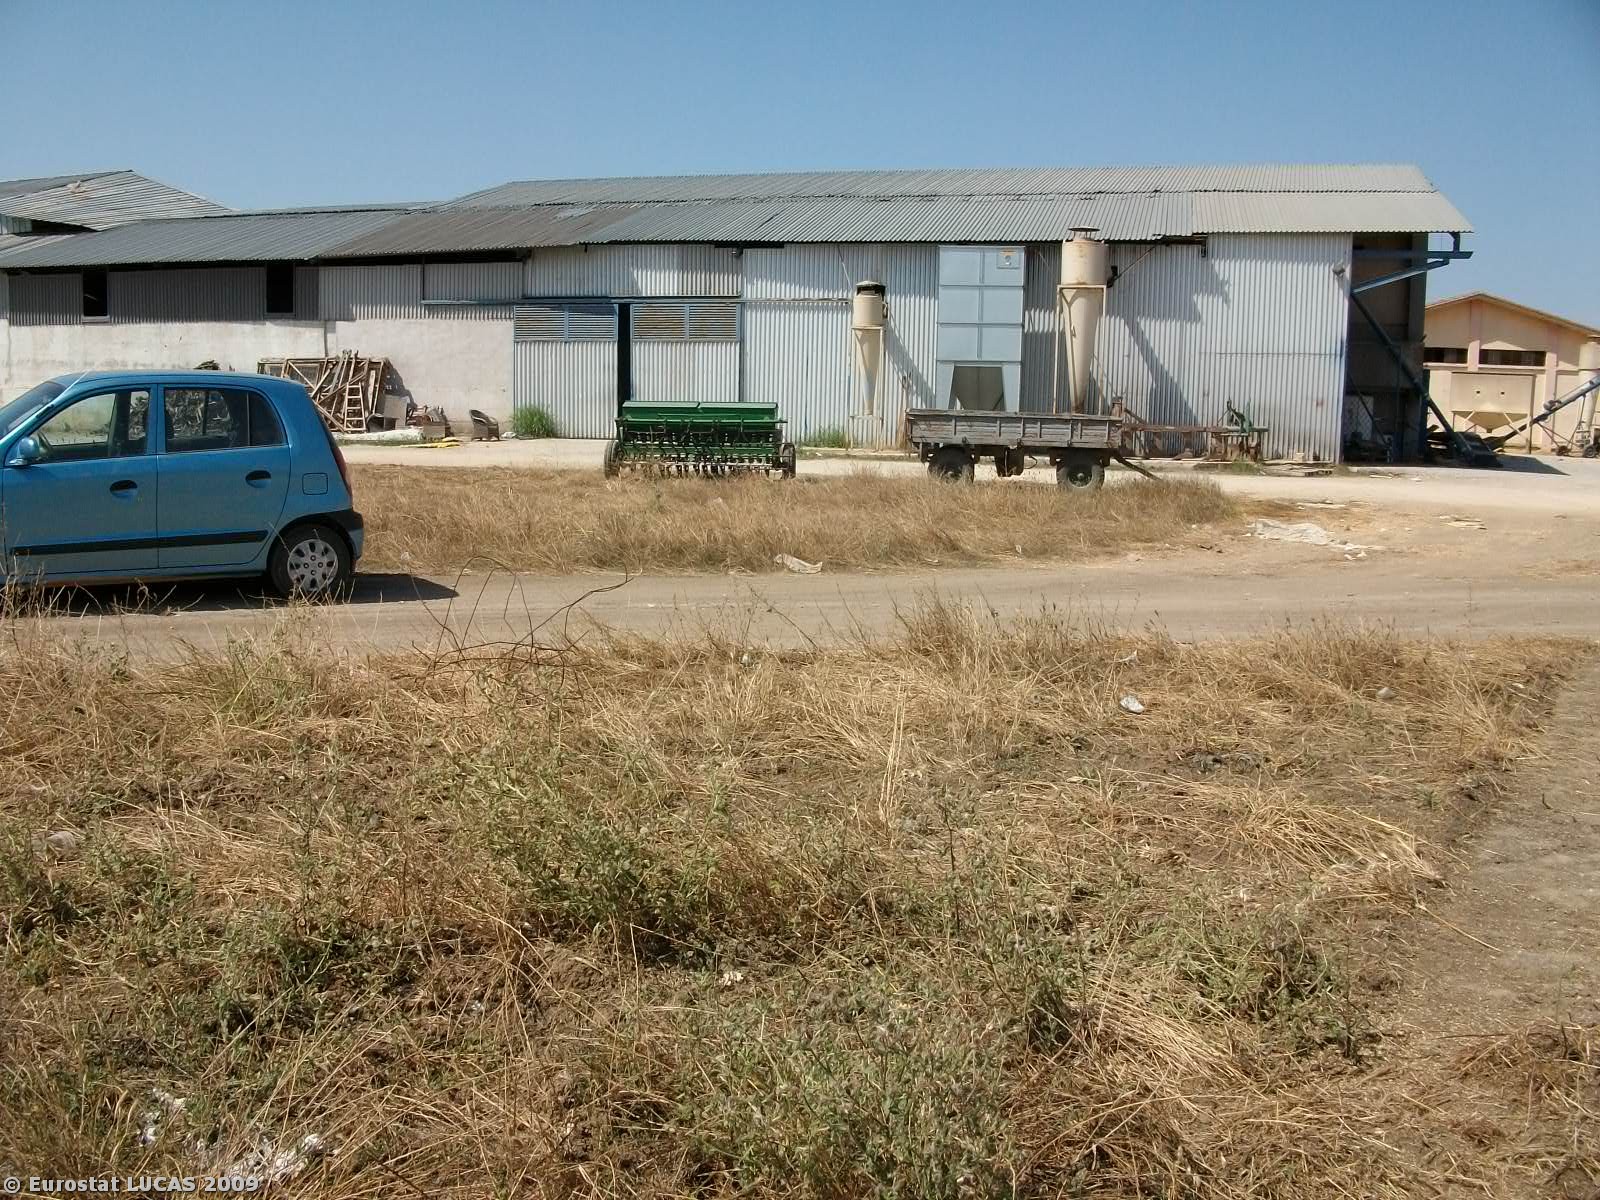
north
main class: Grassland
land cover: Grassland without tree/shrub cover
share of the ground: > 75 %
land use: Unused
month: June
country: GR
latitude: 40.0894
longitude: 23.4356
